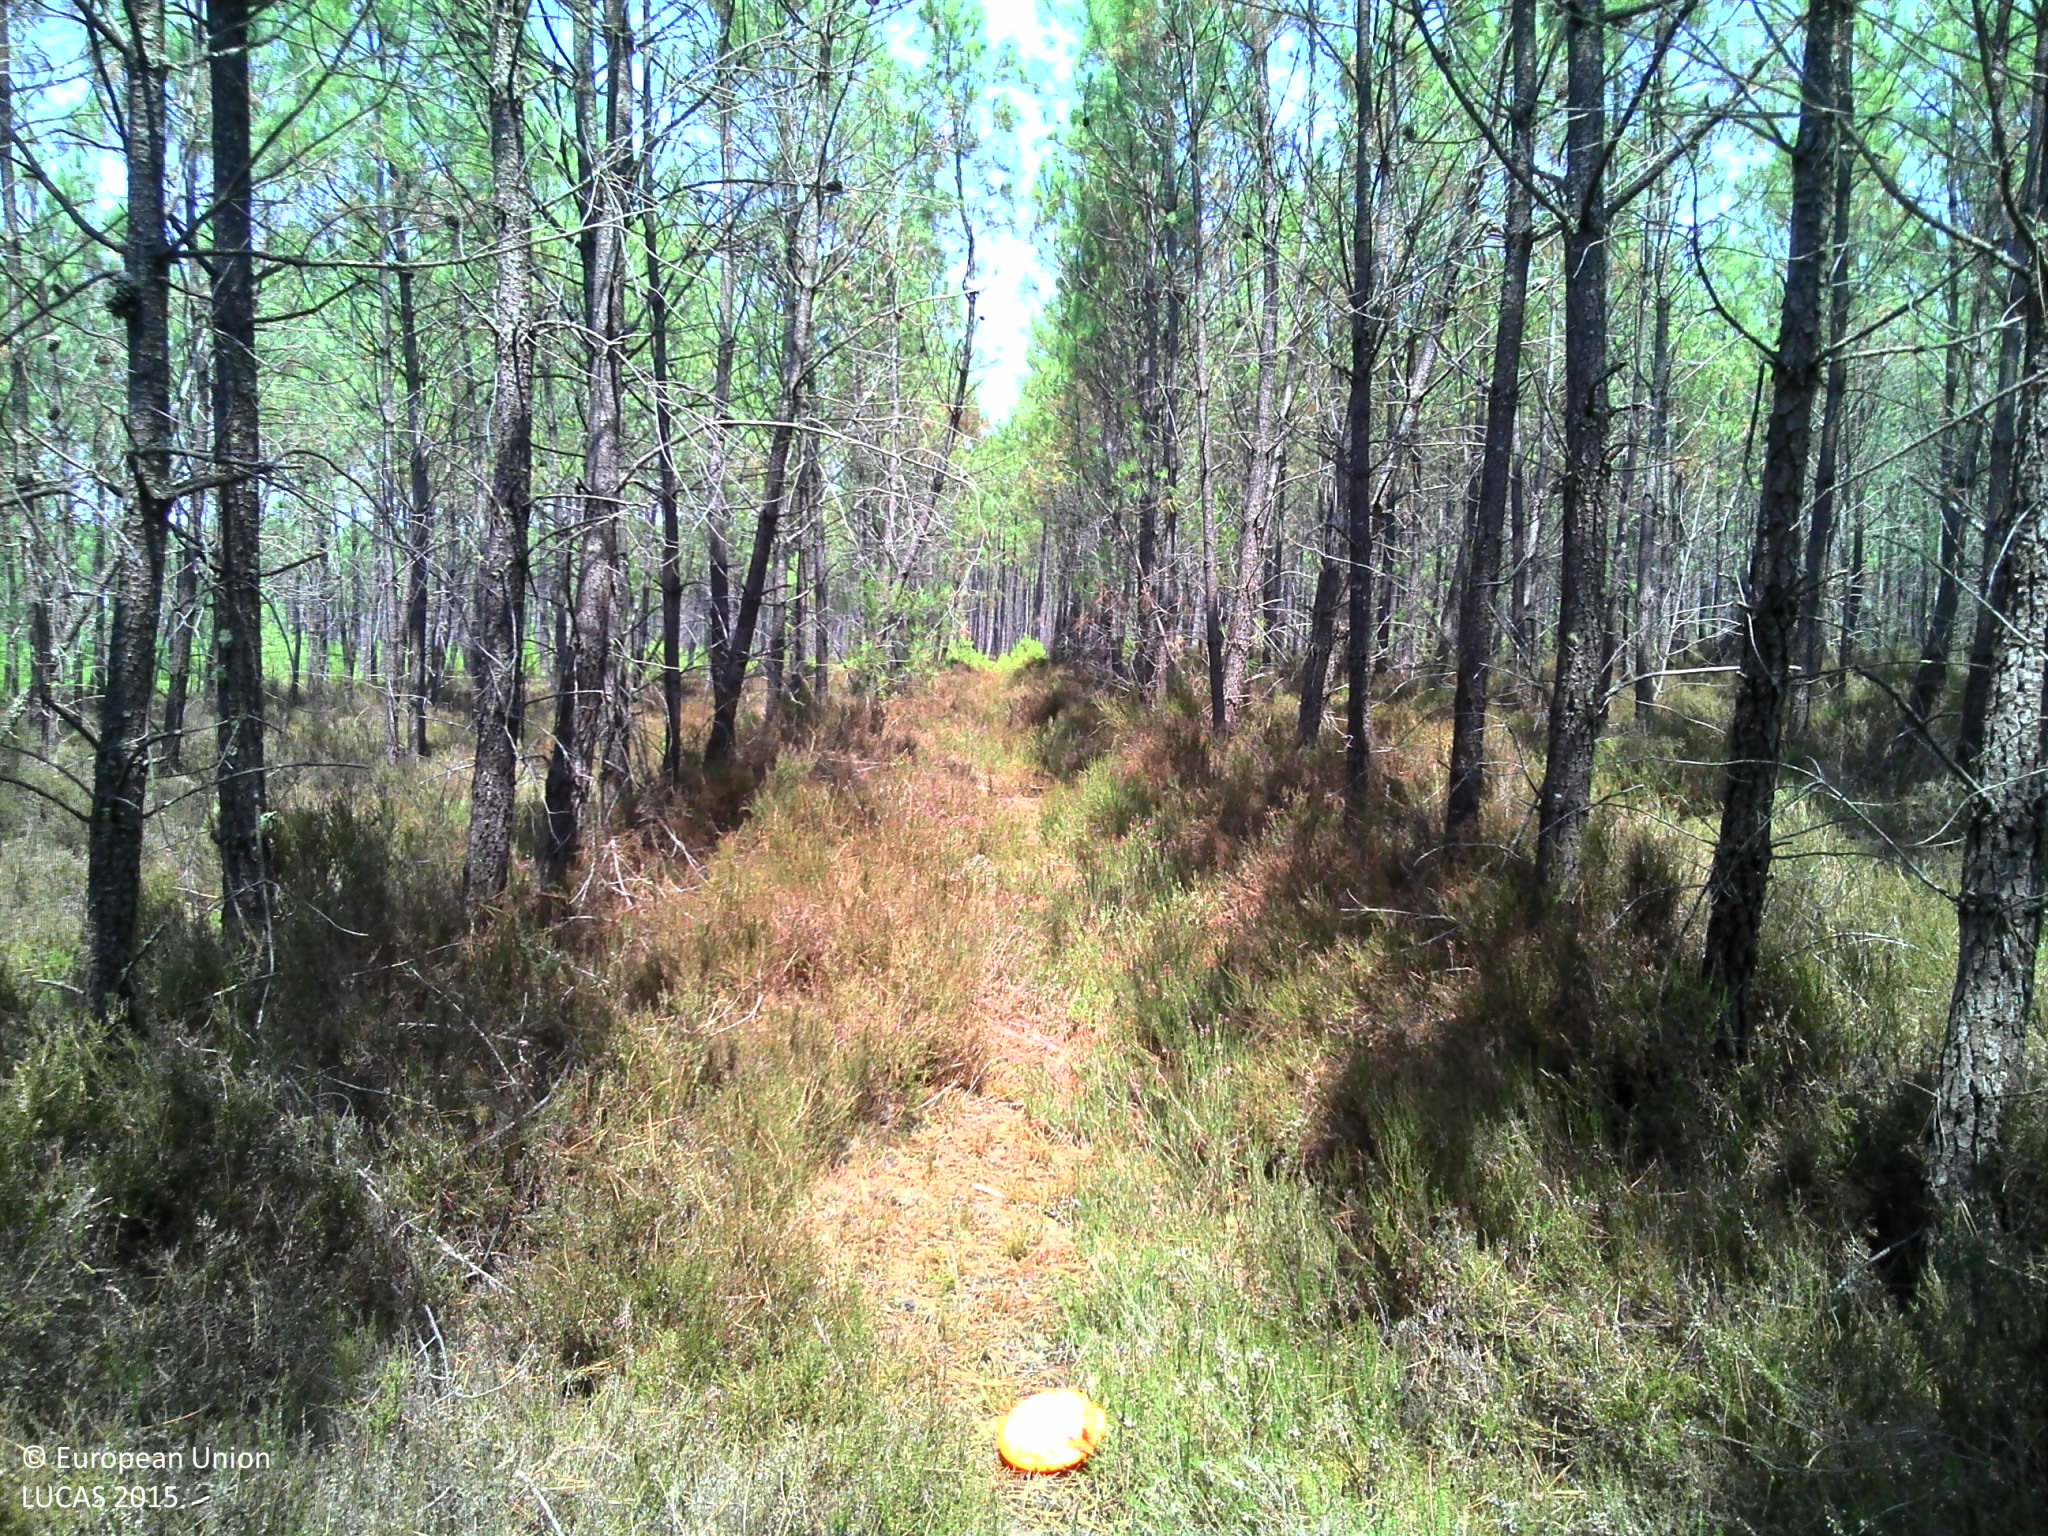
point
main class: Woodland
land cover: Pine dominated coniferous woodland
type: coniferous forest of the mediterranean region
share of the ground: > 75 %
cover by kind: coniferous forest trees 75 %, herbaceous plants 20 %, lichens and mosses 5 %
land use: Forestry
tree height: > 5 m
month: August
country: FR
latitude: 44.1577
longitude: -1.0599
